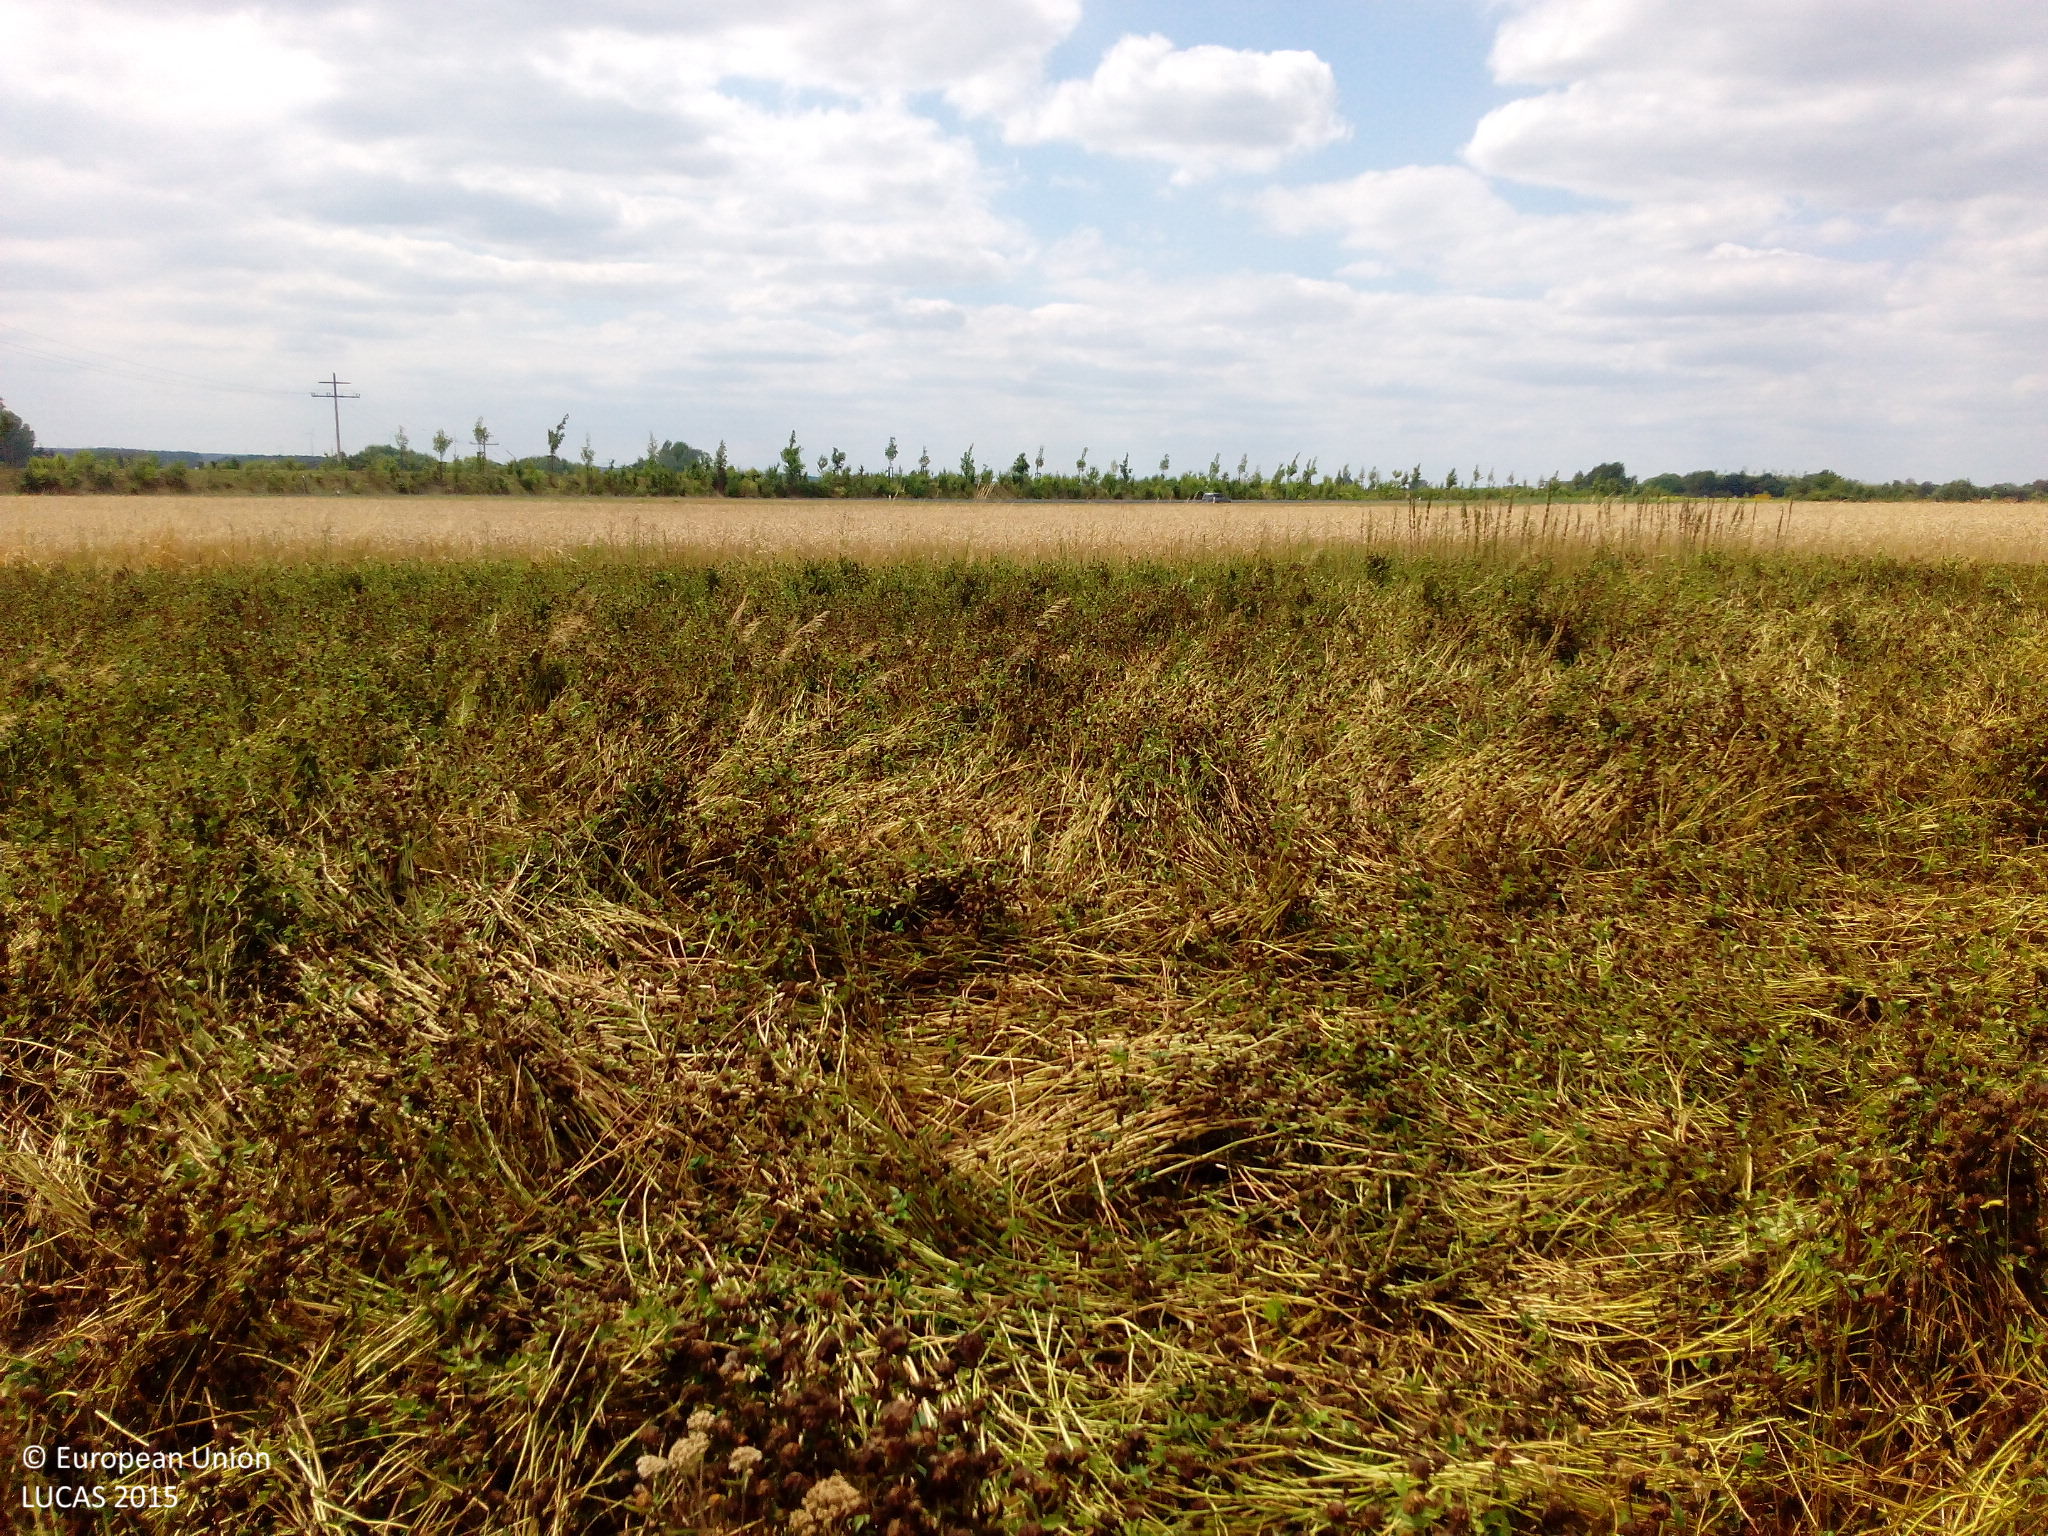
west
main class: Cropland
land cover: Clovers
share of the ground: > 75 %
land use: Agriculture (excluding fallow land and kitchen gardens)
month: July
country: DE
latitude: 49.5690
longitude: 10.9261
